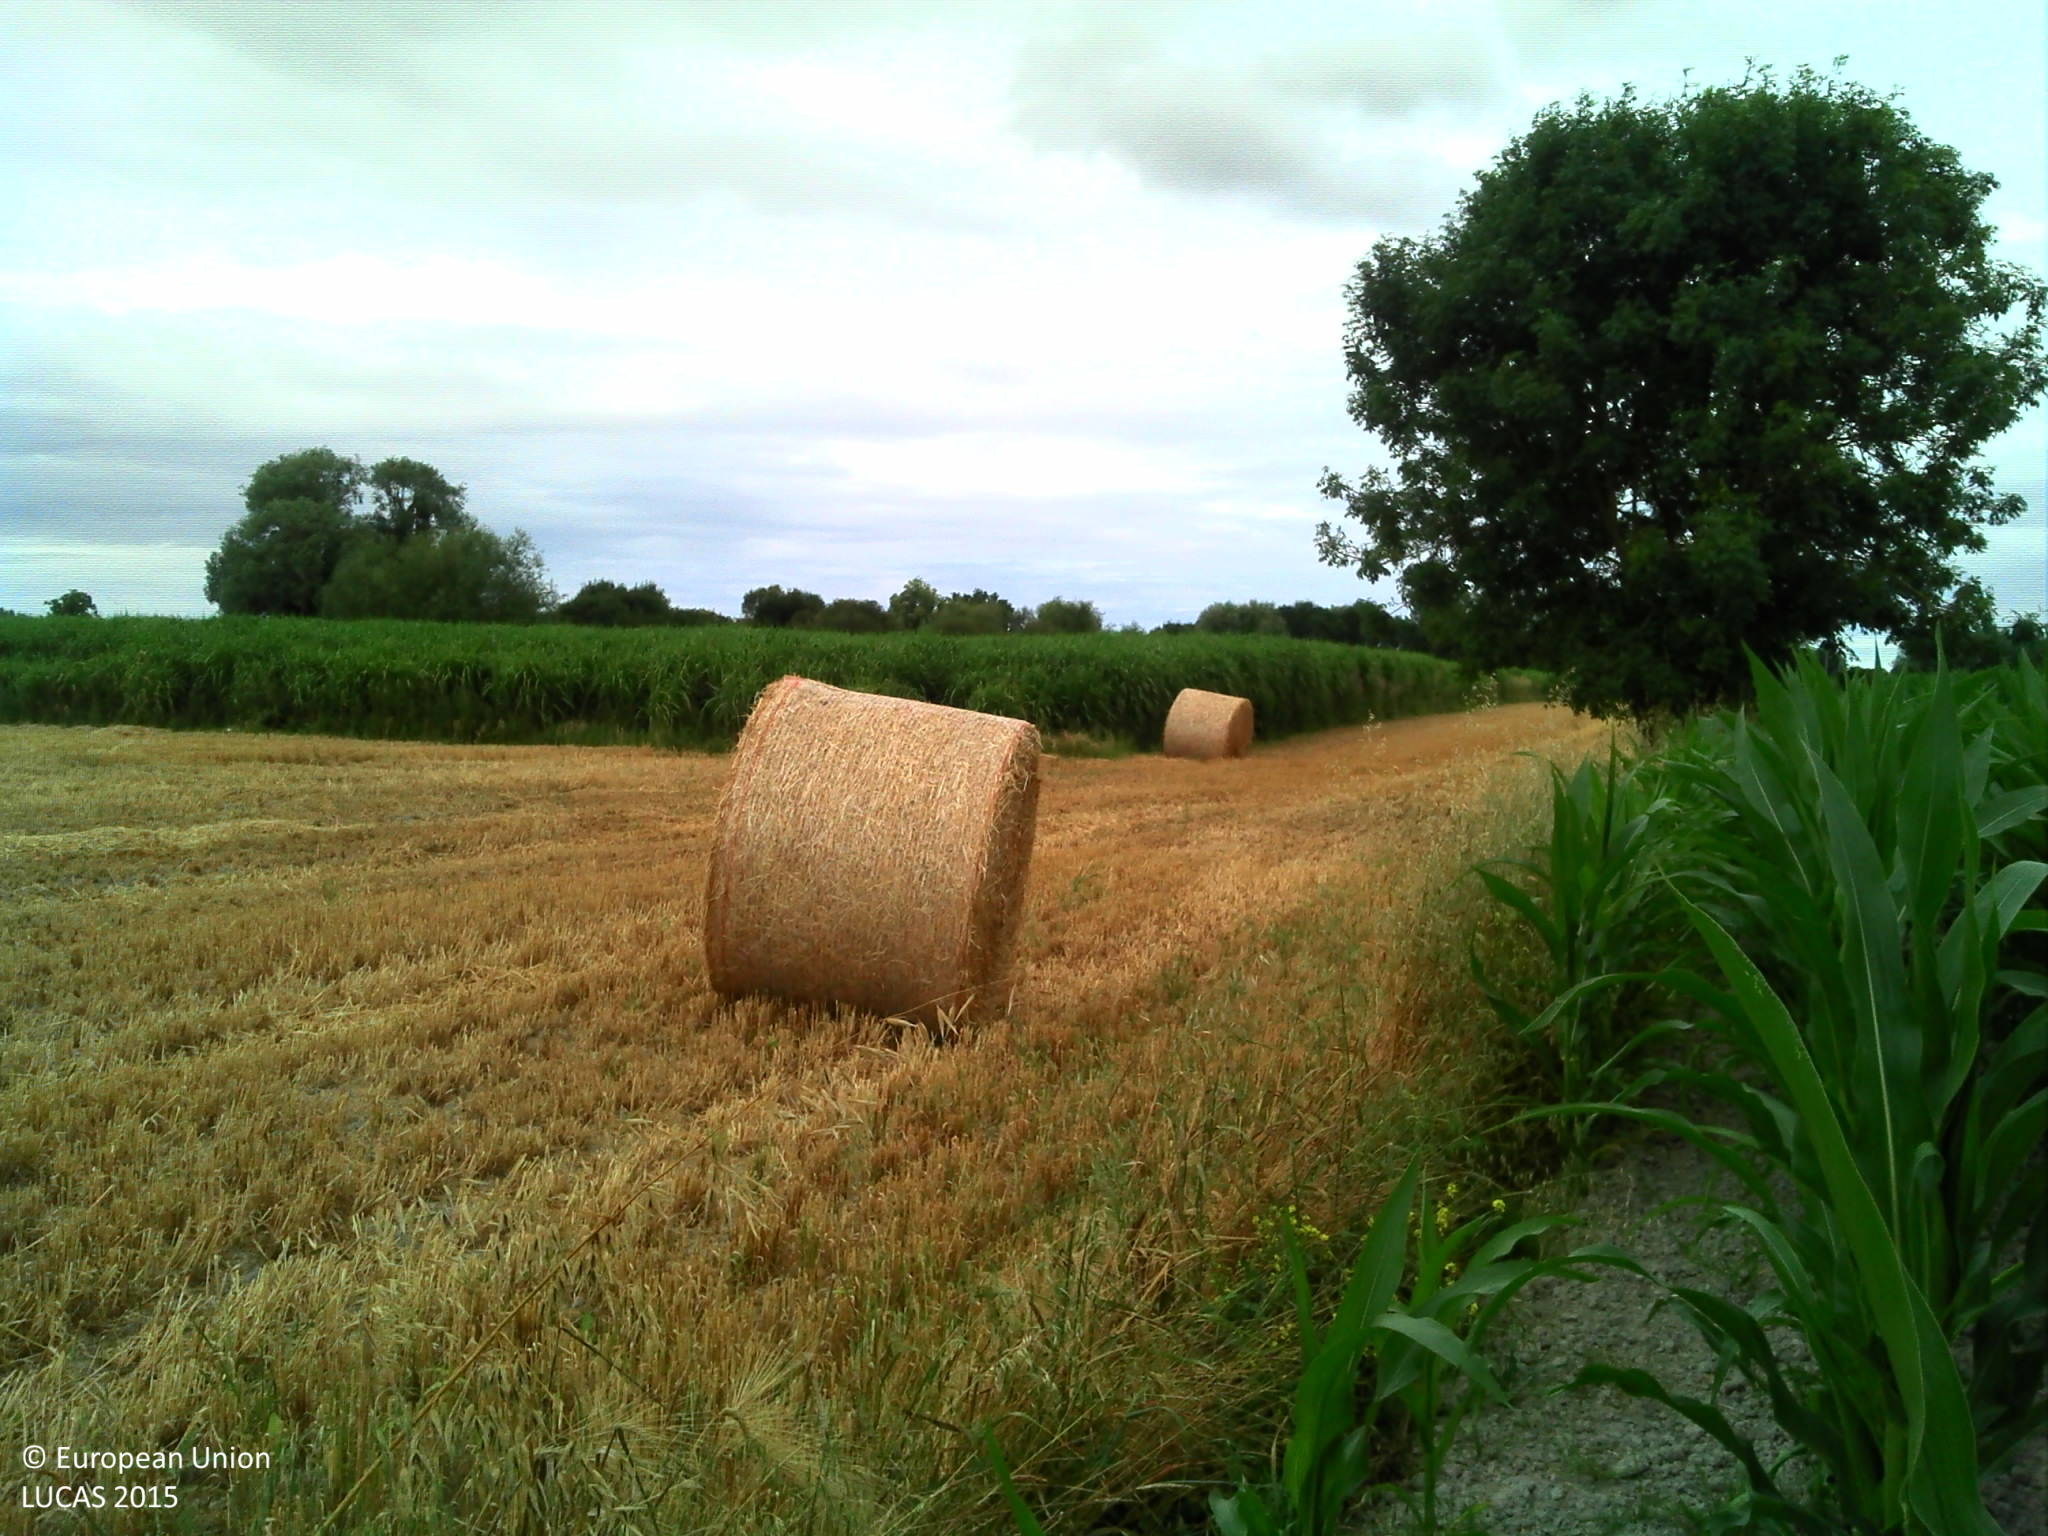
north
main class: Cropland
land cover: Maize
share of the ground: > 75 %
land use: Agriculture (excluding fallow land and kitchen gardens)
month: July
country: FR
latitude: 48.5987
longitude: -1.8632
